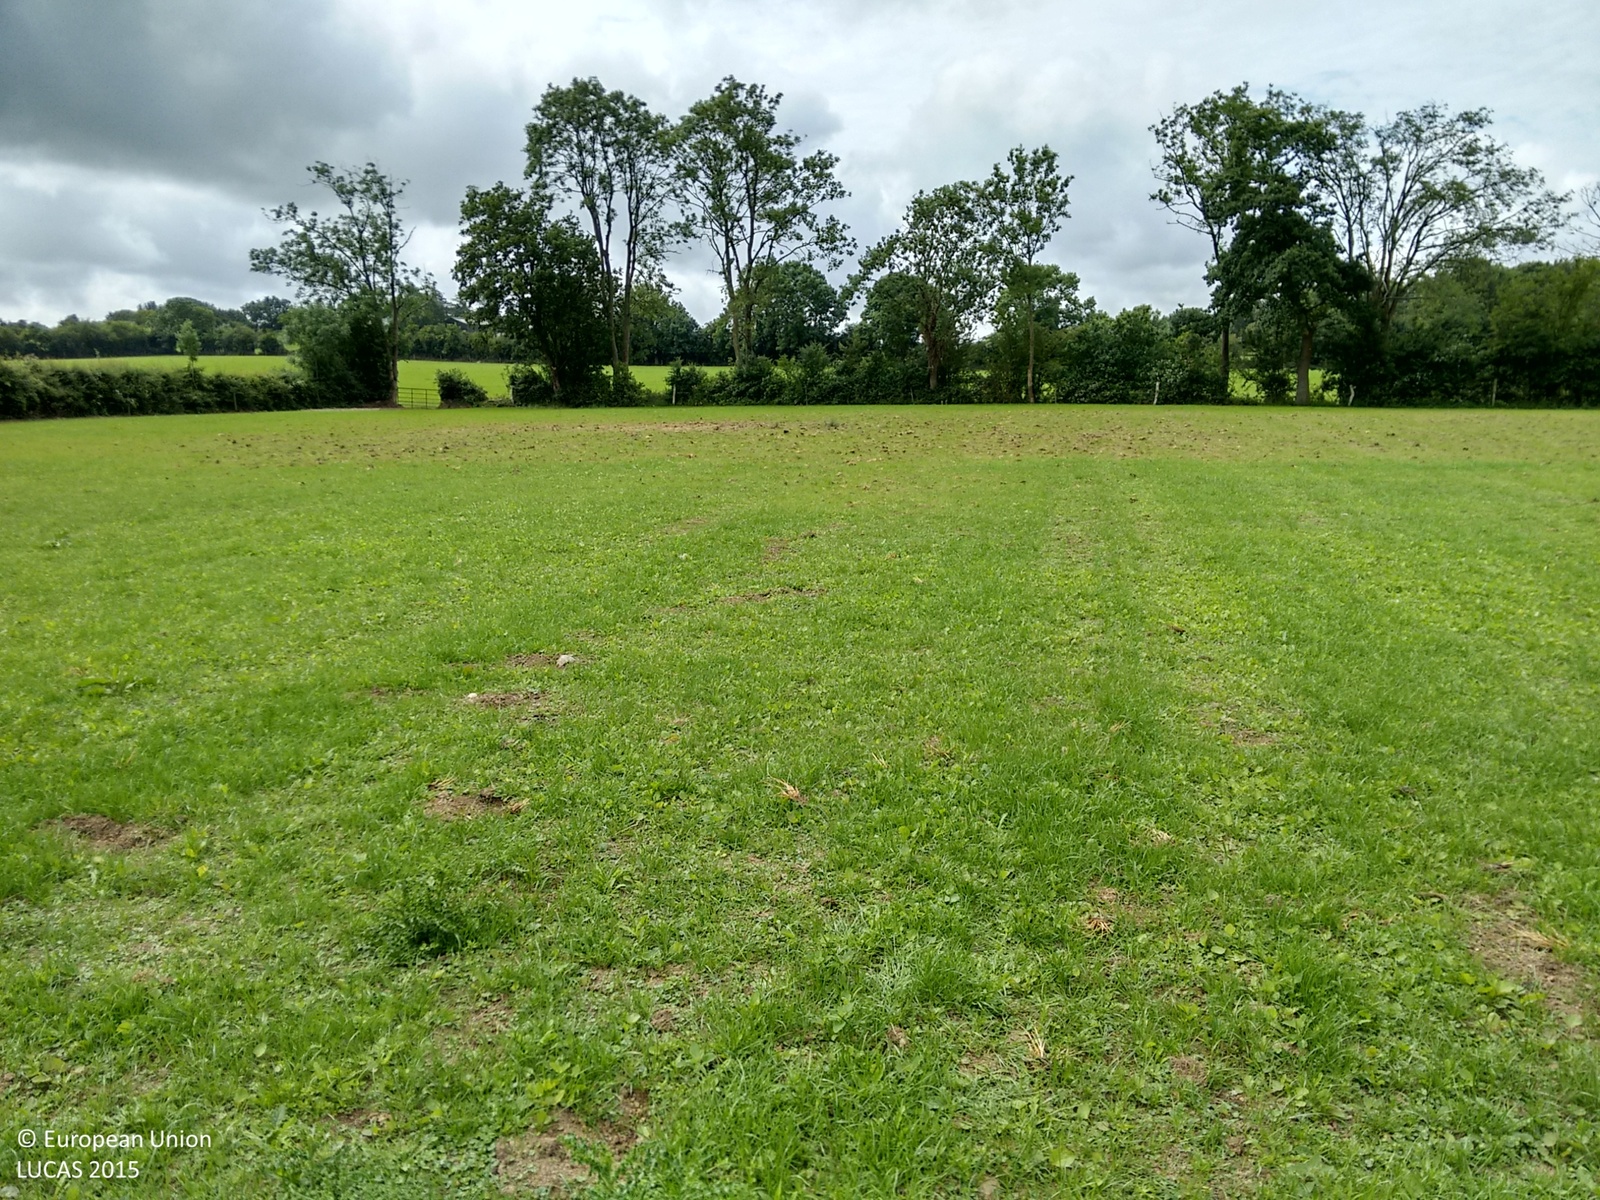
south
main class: Grassland
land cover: Grassland without tree/shrub cover
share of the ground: > 75 %
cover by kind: herbaceous plants 95 %, unconsolidated bare surface 5 %
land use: Agriculture (excluding fallow land and kitchen gardens)
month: June
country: IE
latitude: 52.3432
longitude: -7.3121
